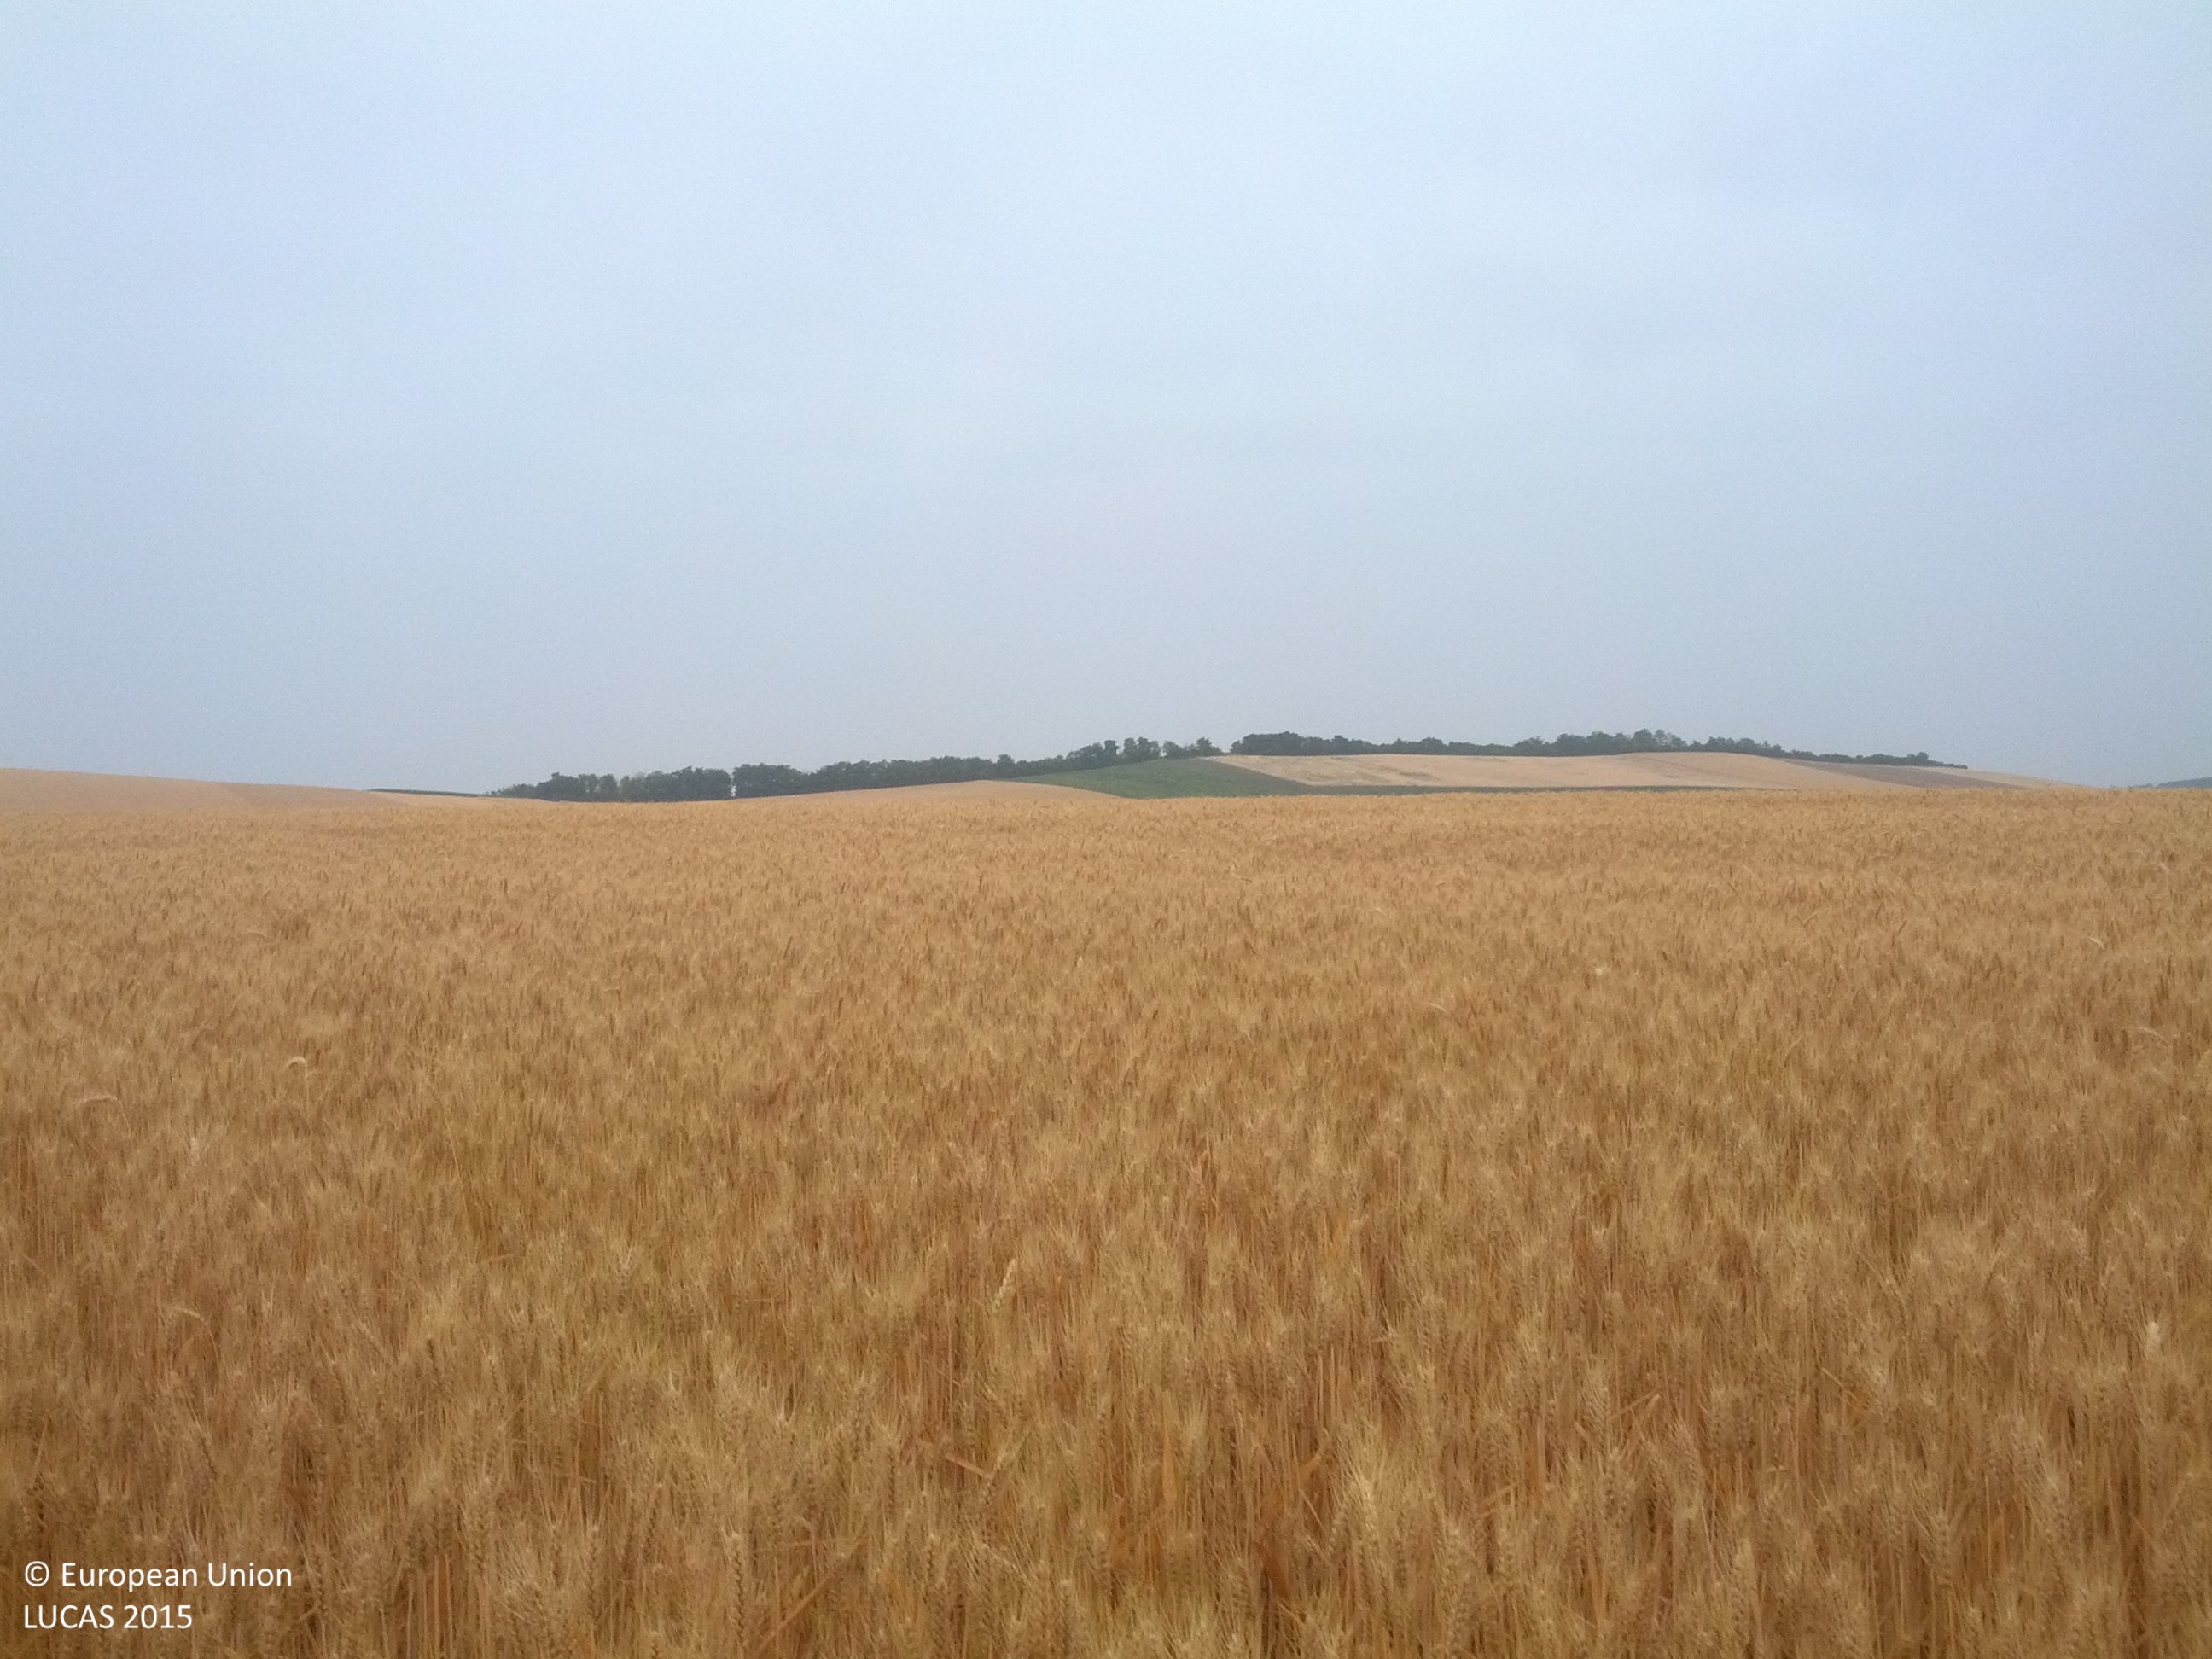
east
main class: Cropland
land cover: Common wheat
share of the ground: > 75 %
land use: Agriculture (excluding fallow land and kitchen gardens)
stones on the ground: 10 - 25 %
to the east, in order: Common wheat; Other cereals
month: July
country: AT
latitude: 48.7703
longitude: 16.5239
